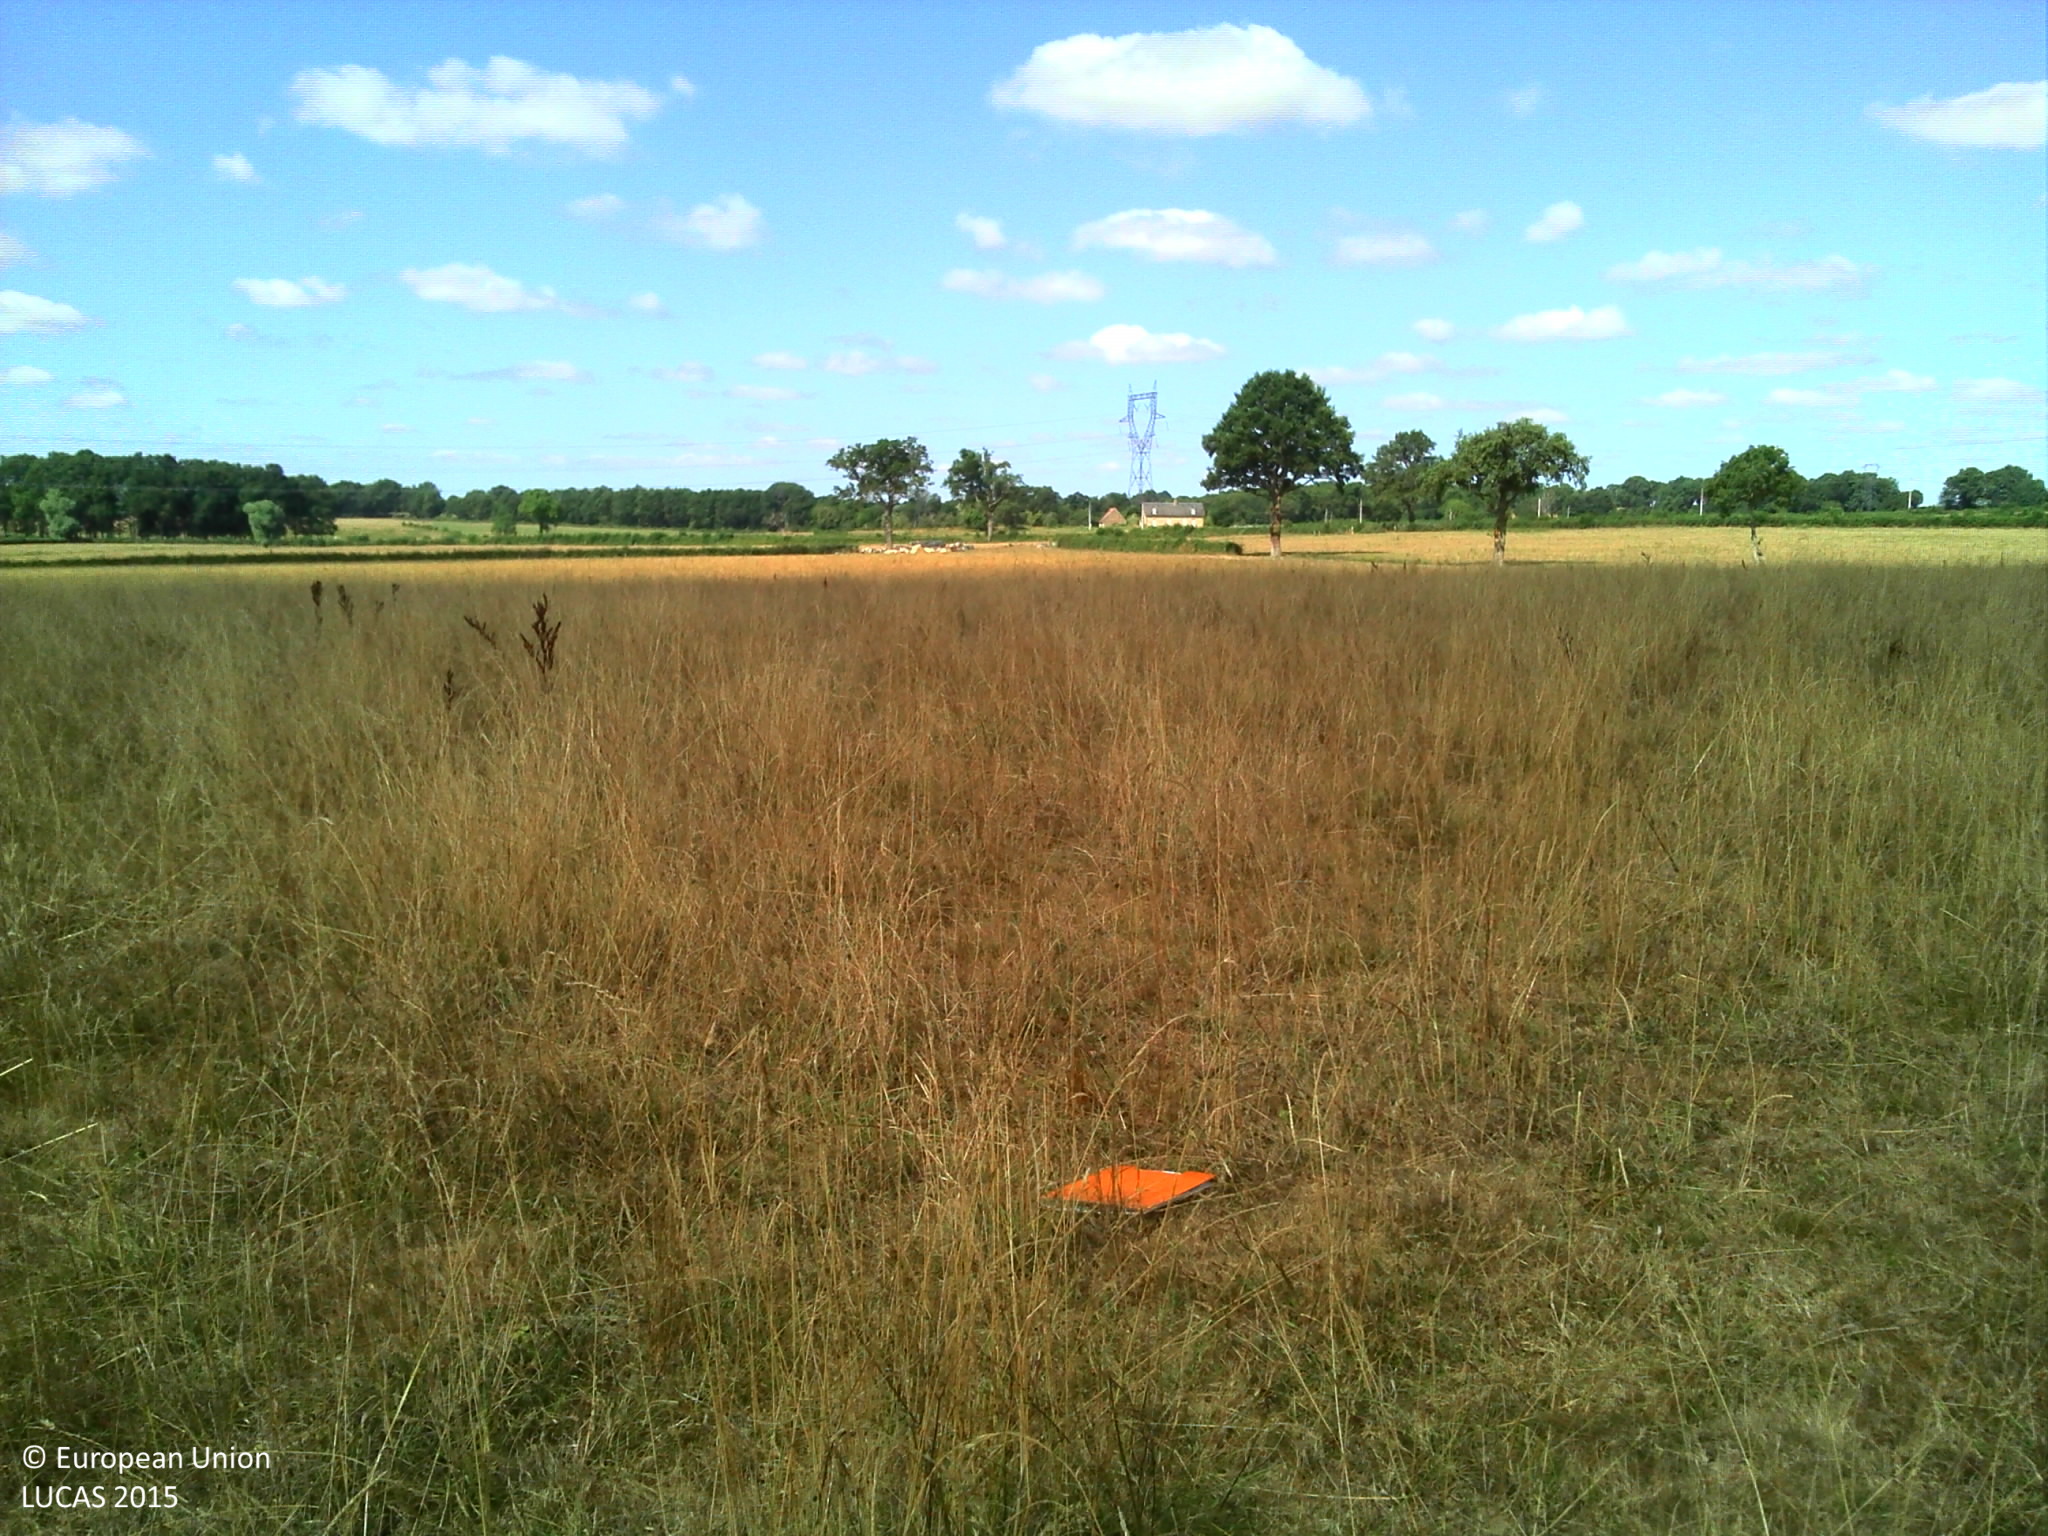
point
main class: Grassland
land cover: Grassland without tree/shrub cover
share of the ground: > 75 %
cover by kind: herbaceous plants 100 %
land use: Agriculture (excluding fallow land and kitchen gardens)
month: July
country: FR
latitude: 46.5568
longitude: 3.0186
